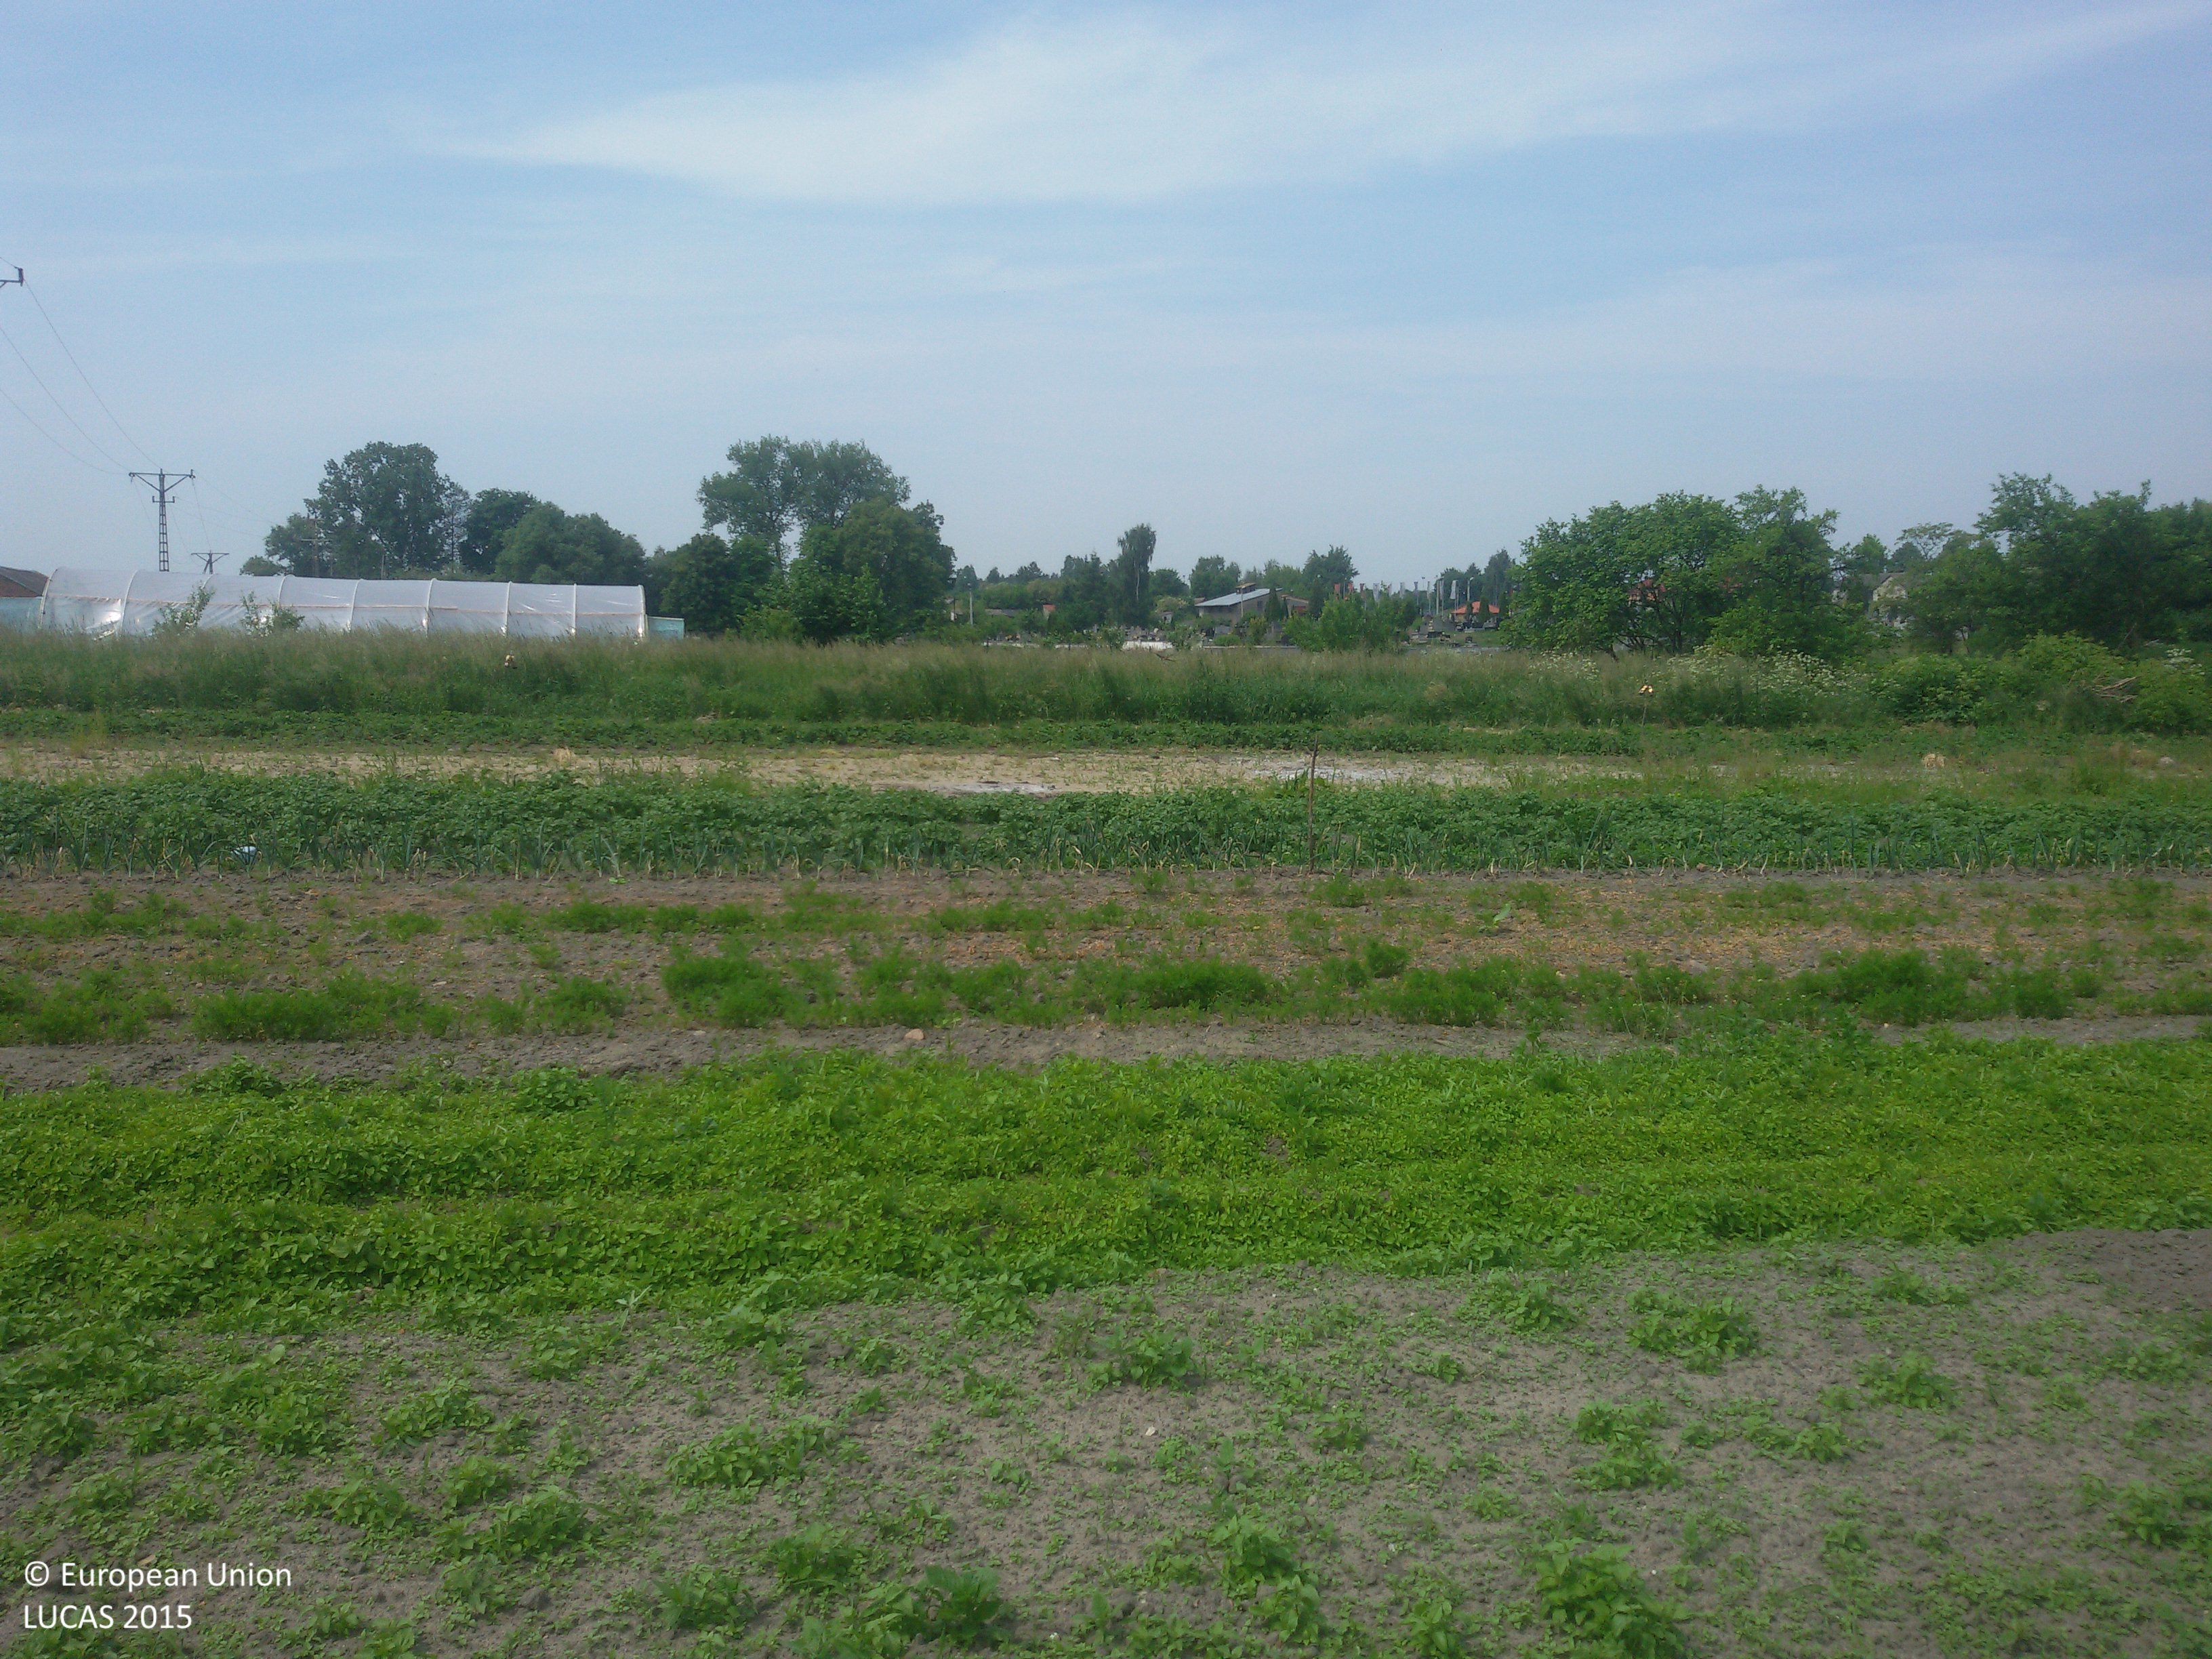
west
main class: Cropland
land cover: Potatoes
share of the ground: > 75 %
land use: Agriculture (excluding fallow land and kitchen gardens)
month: June
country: PL
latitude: 51.5354
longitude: 20.6363
